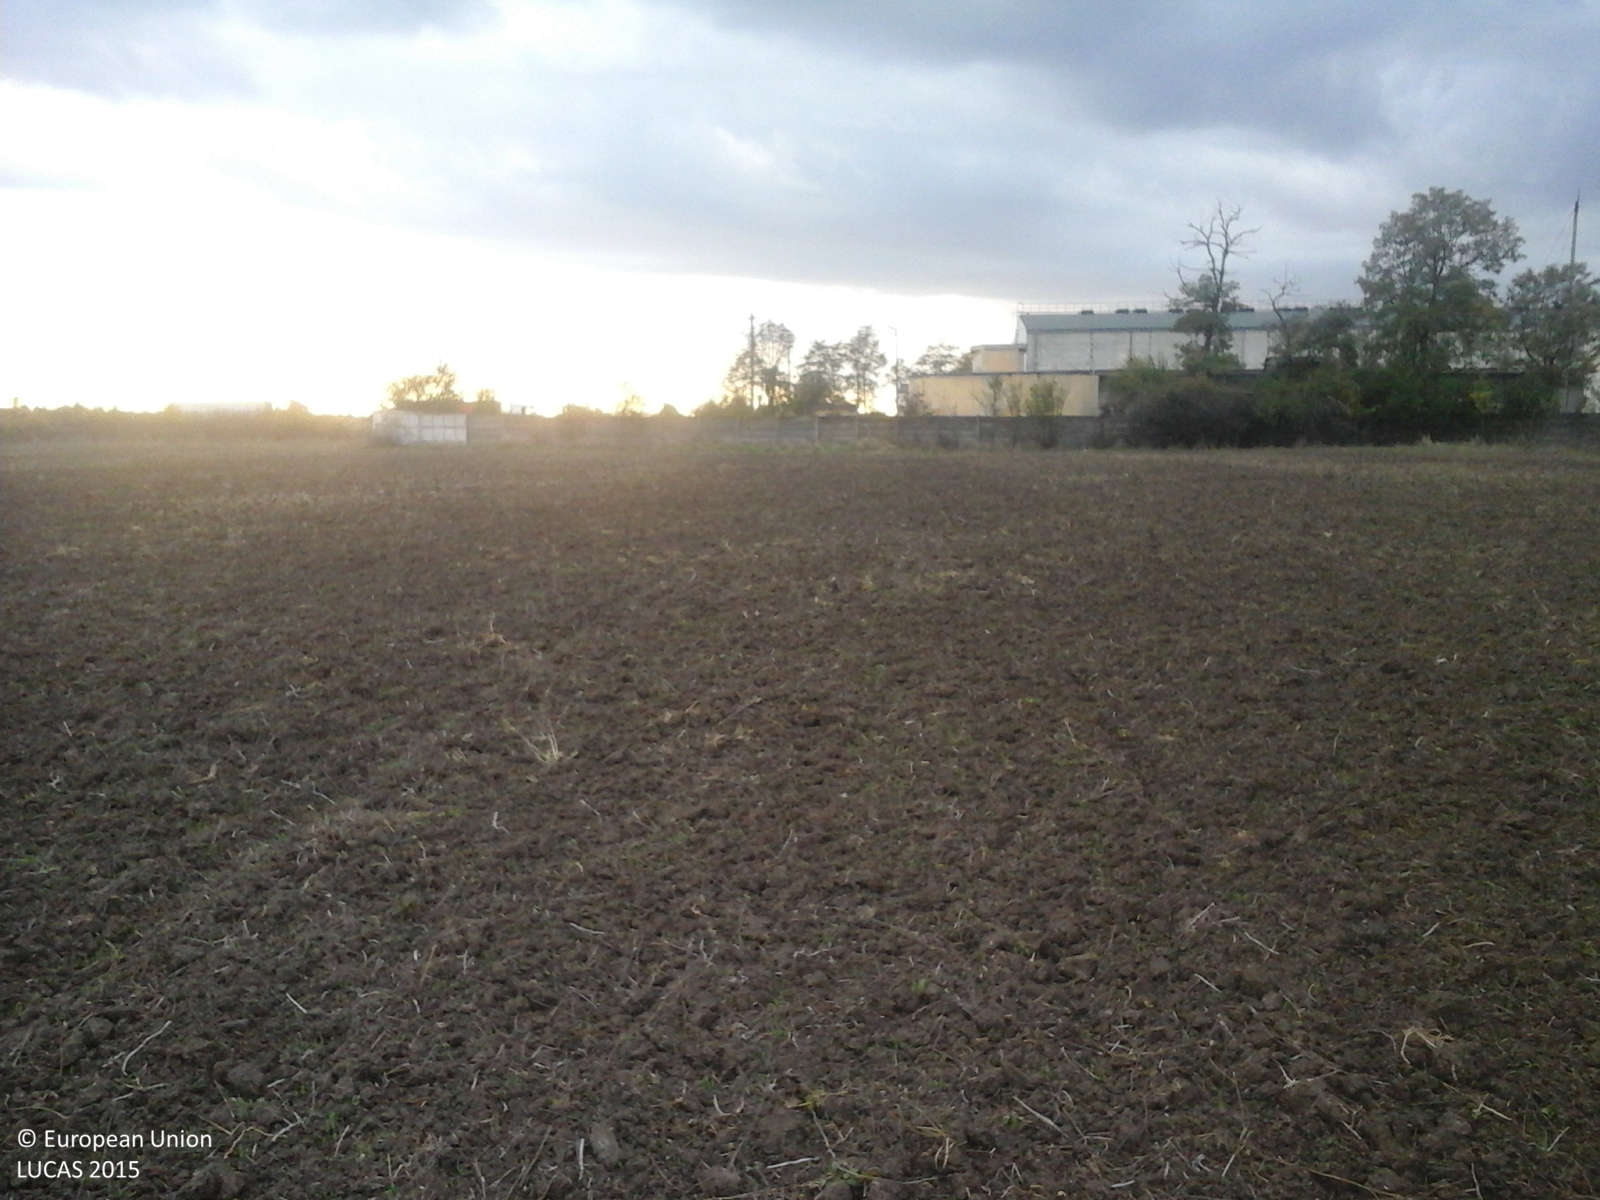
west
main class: Cropland
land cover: Common wheat
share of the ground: < 10 %
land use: Agriculture (excluding fallow land and kitchen gardens)
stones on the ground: < 10 %
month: October
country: RO
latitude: 44.9239
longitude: 25.5922
